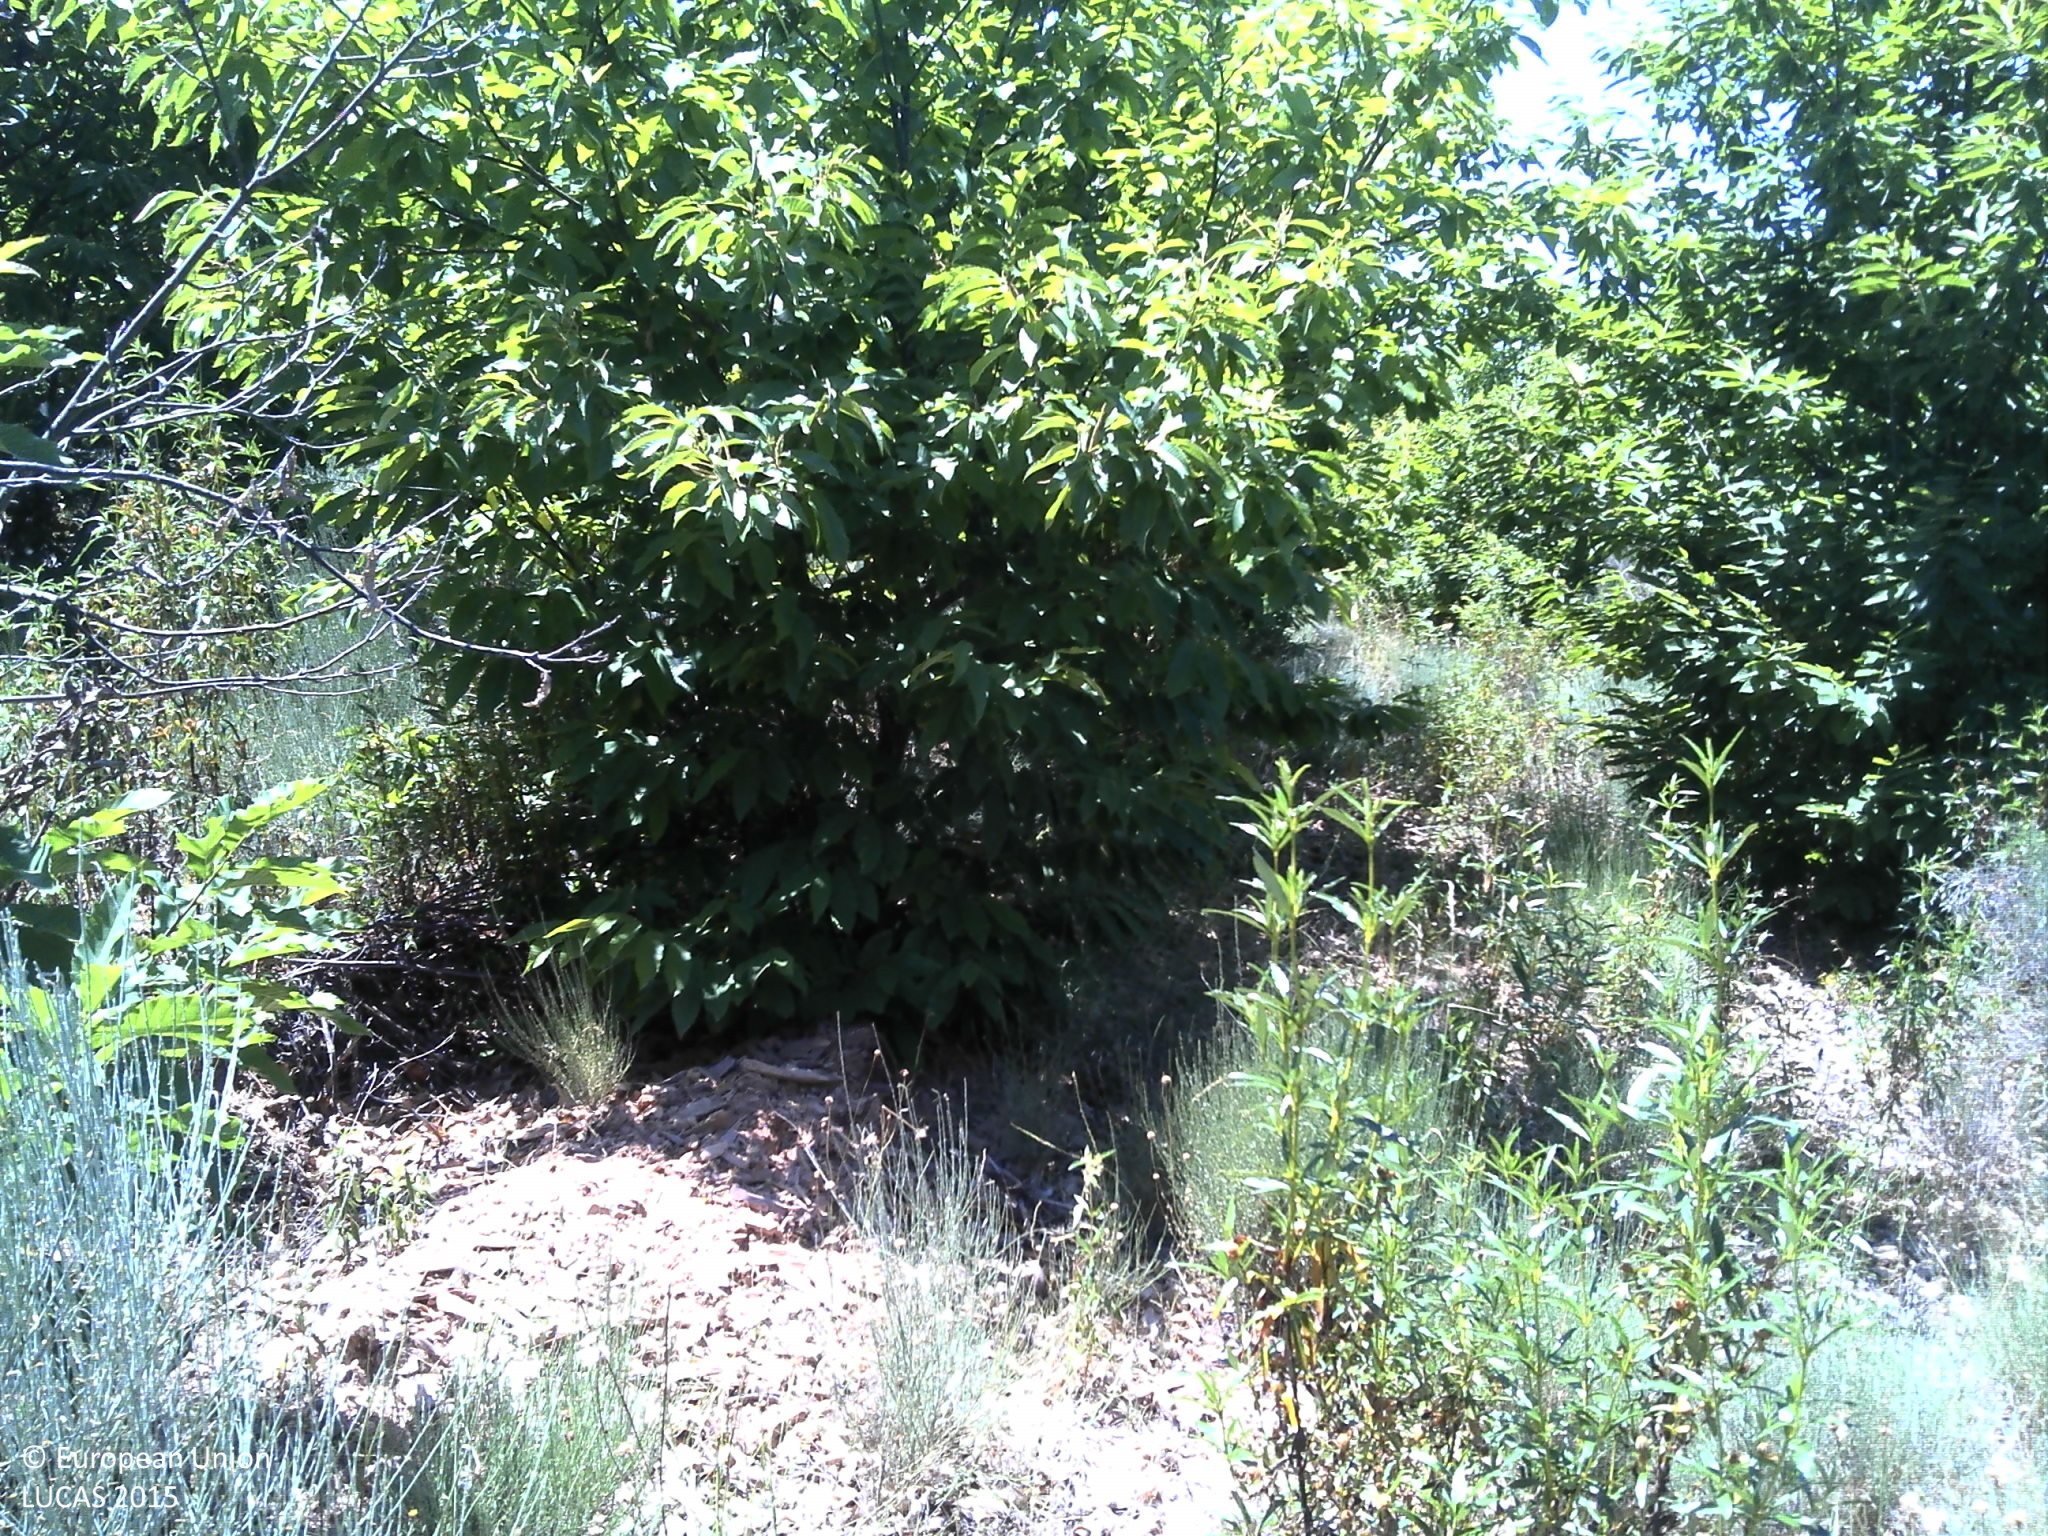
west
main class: Woodland
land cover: Broadleaved woodland
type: thermophilous deciduous forest
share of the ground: 10 - 25 %
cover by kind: shrubs 80 %, broadleaved forest trees 20 %
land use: Forestry
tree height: < 5 m
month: June
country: PT
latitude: 41.0489
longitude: -6.9409
